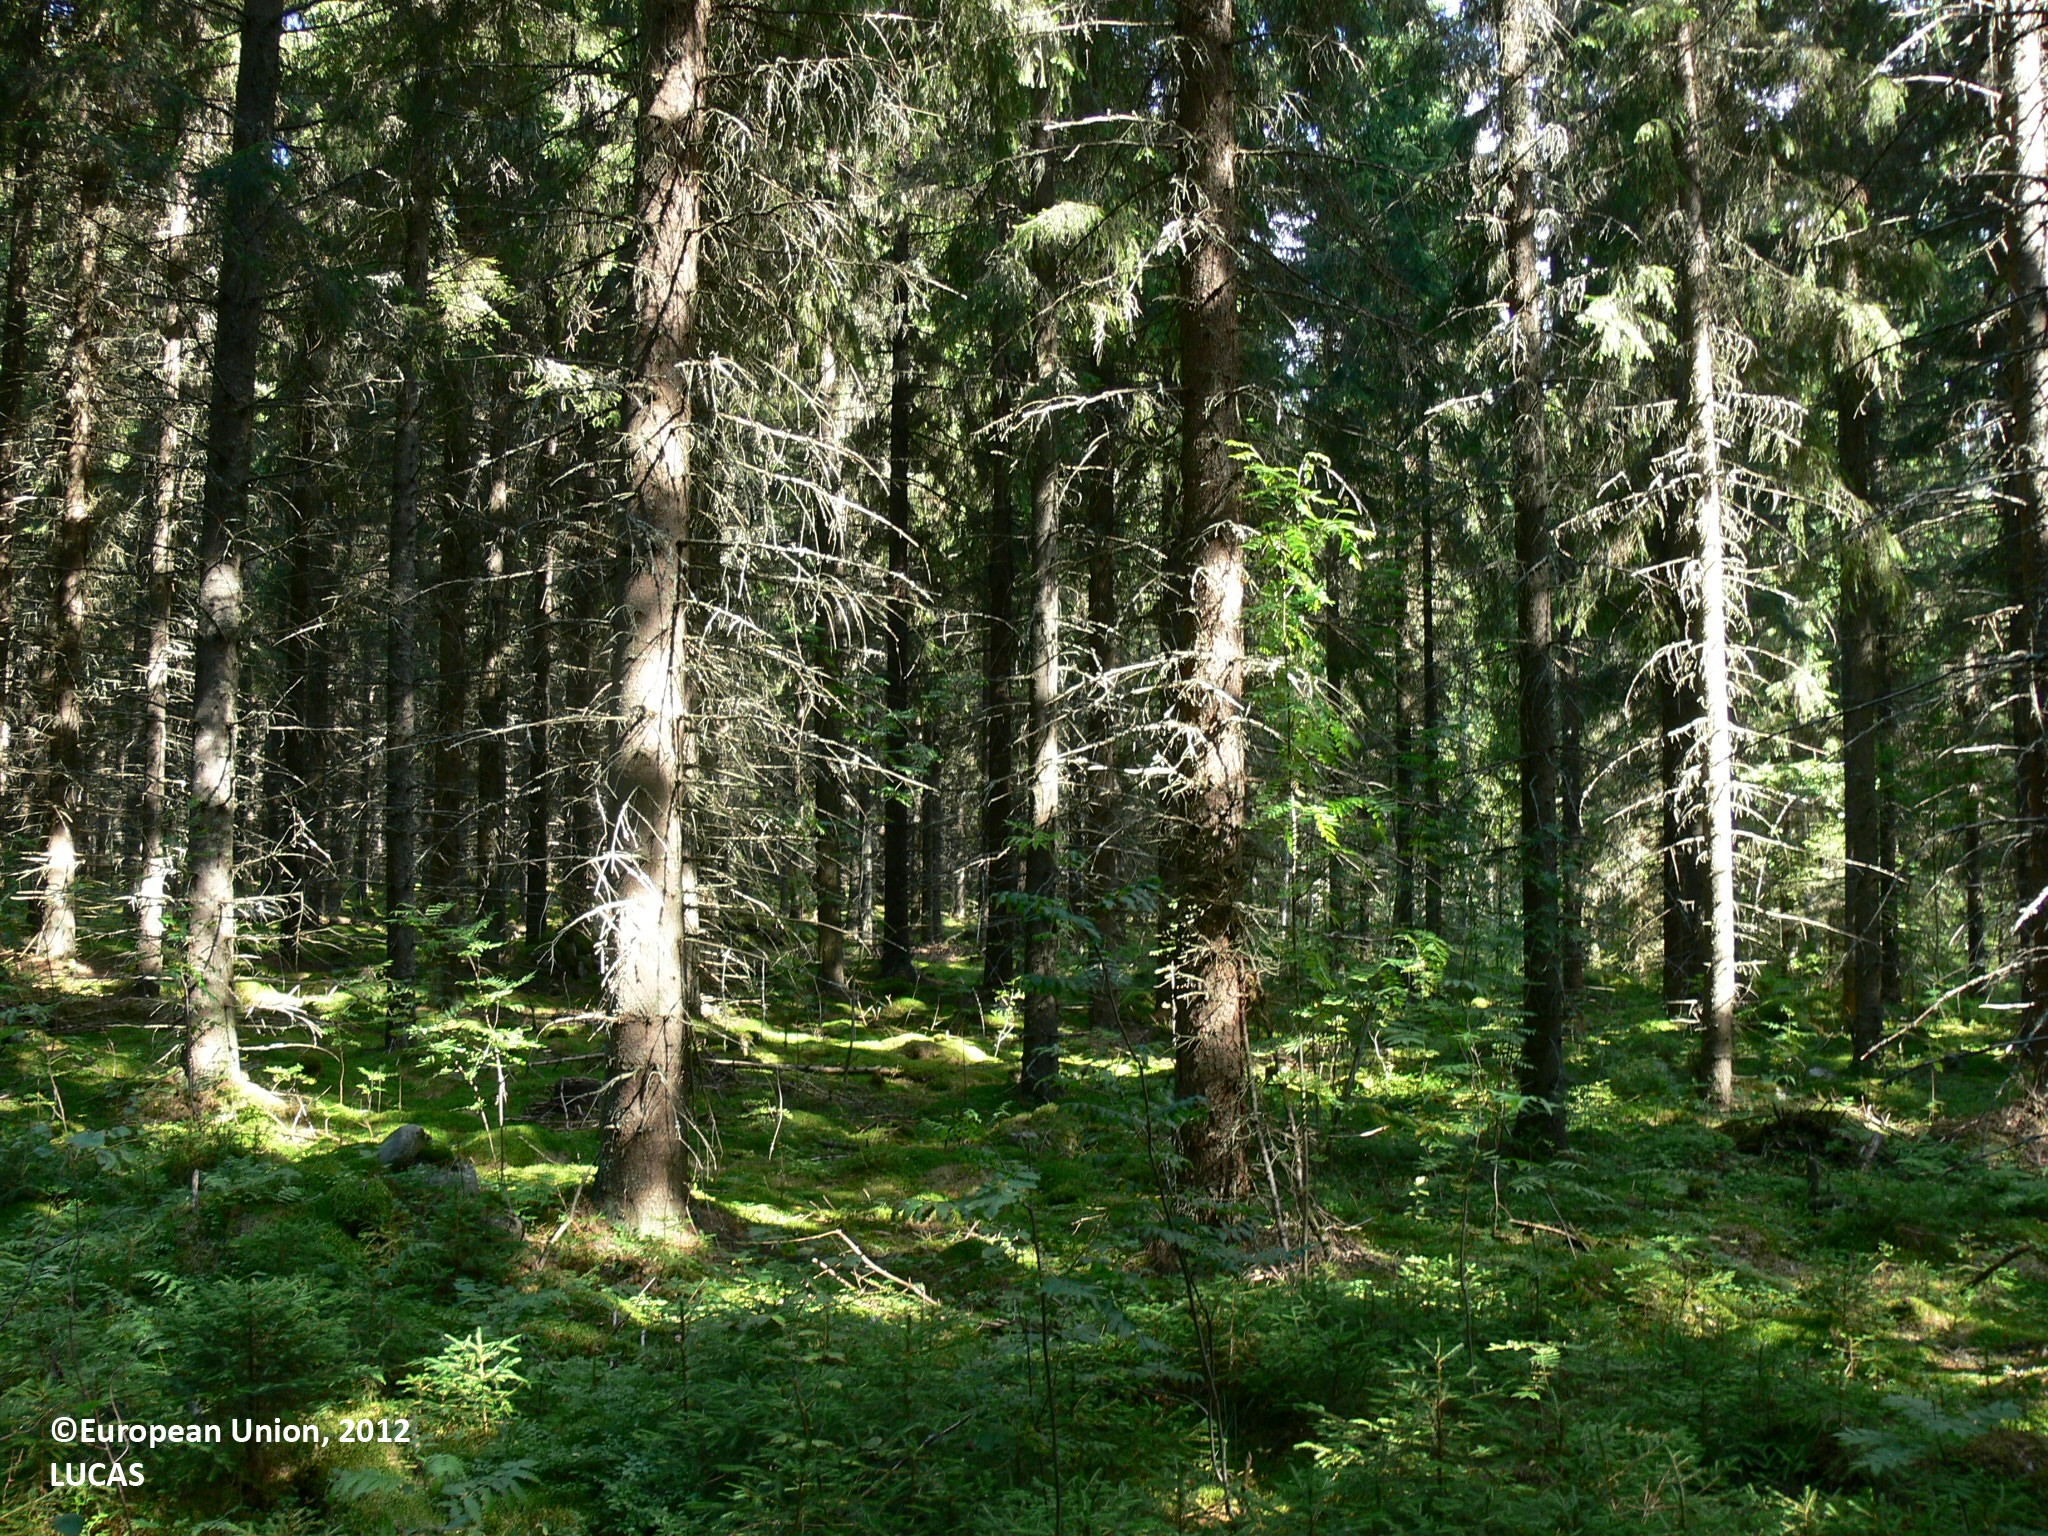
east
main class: Woodland
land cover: Spruce dominated coniferous woodland
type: boreal forest
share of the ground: > 75 %
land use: Forestry
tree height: > 5 m
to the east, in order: Spruce dominated coniferous woodland
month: August
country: FI
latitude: 62.0076
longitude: 29.3570
